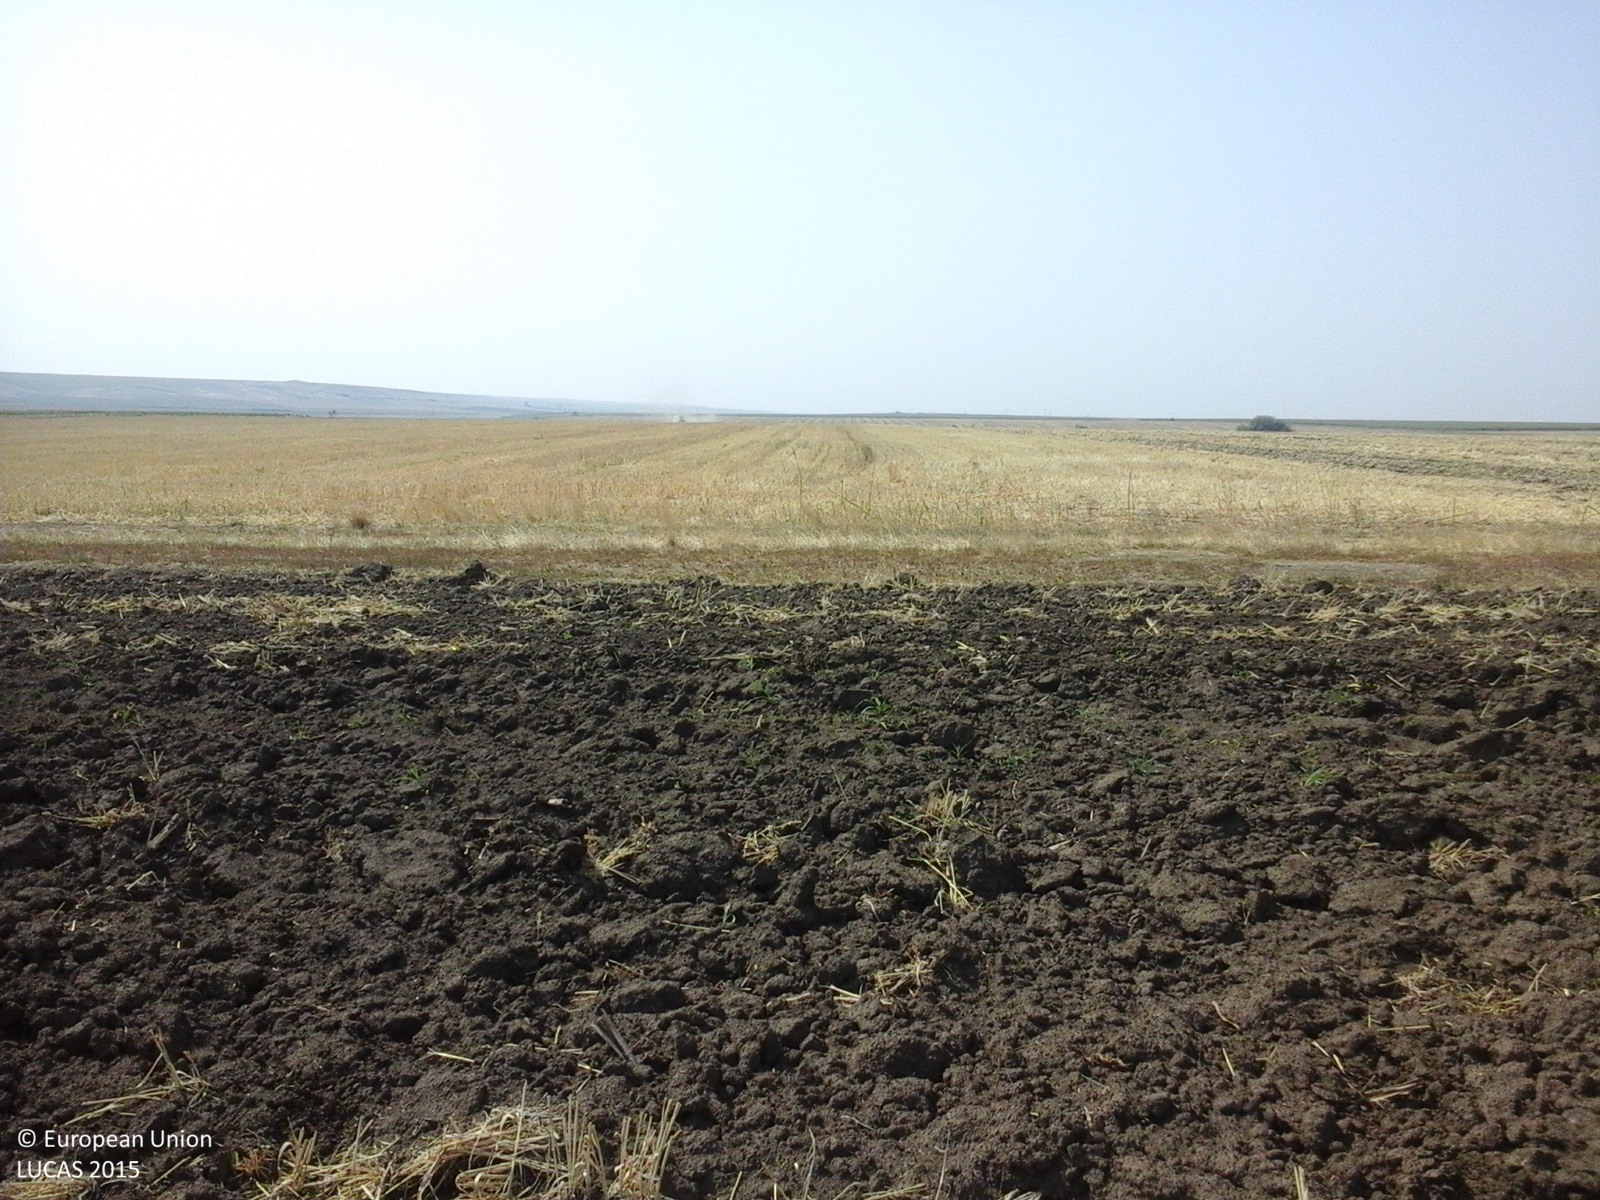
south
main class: Cropland
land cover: Common wheat
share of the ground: < 10 %
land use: Agriculture (excluding fallow land and kitchen gardens)
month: July
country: RO
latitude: 45.6907
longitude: 27.6892
